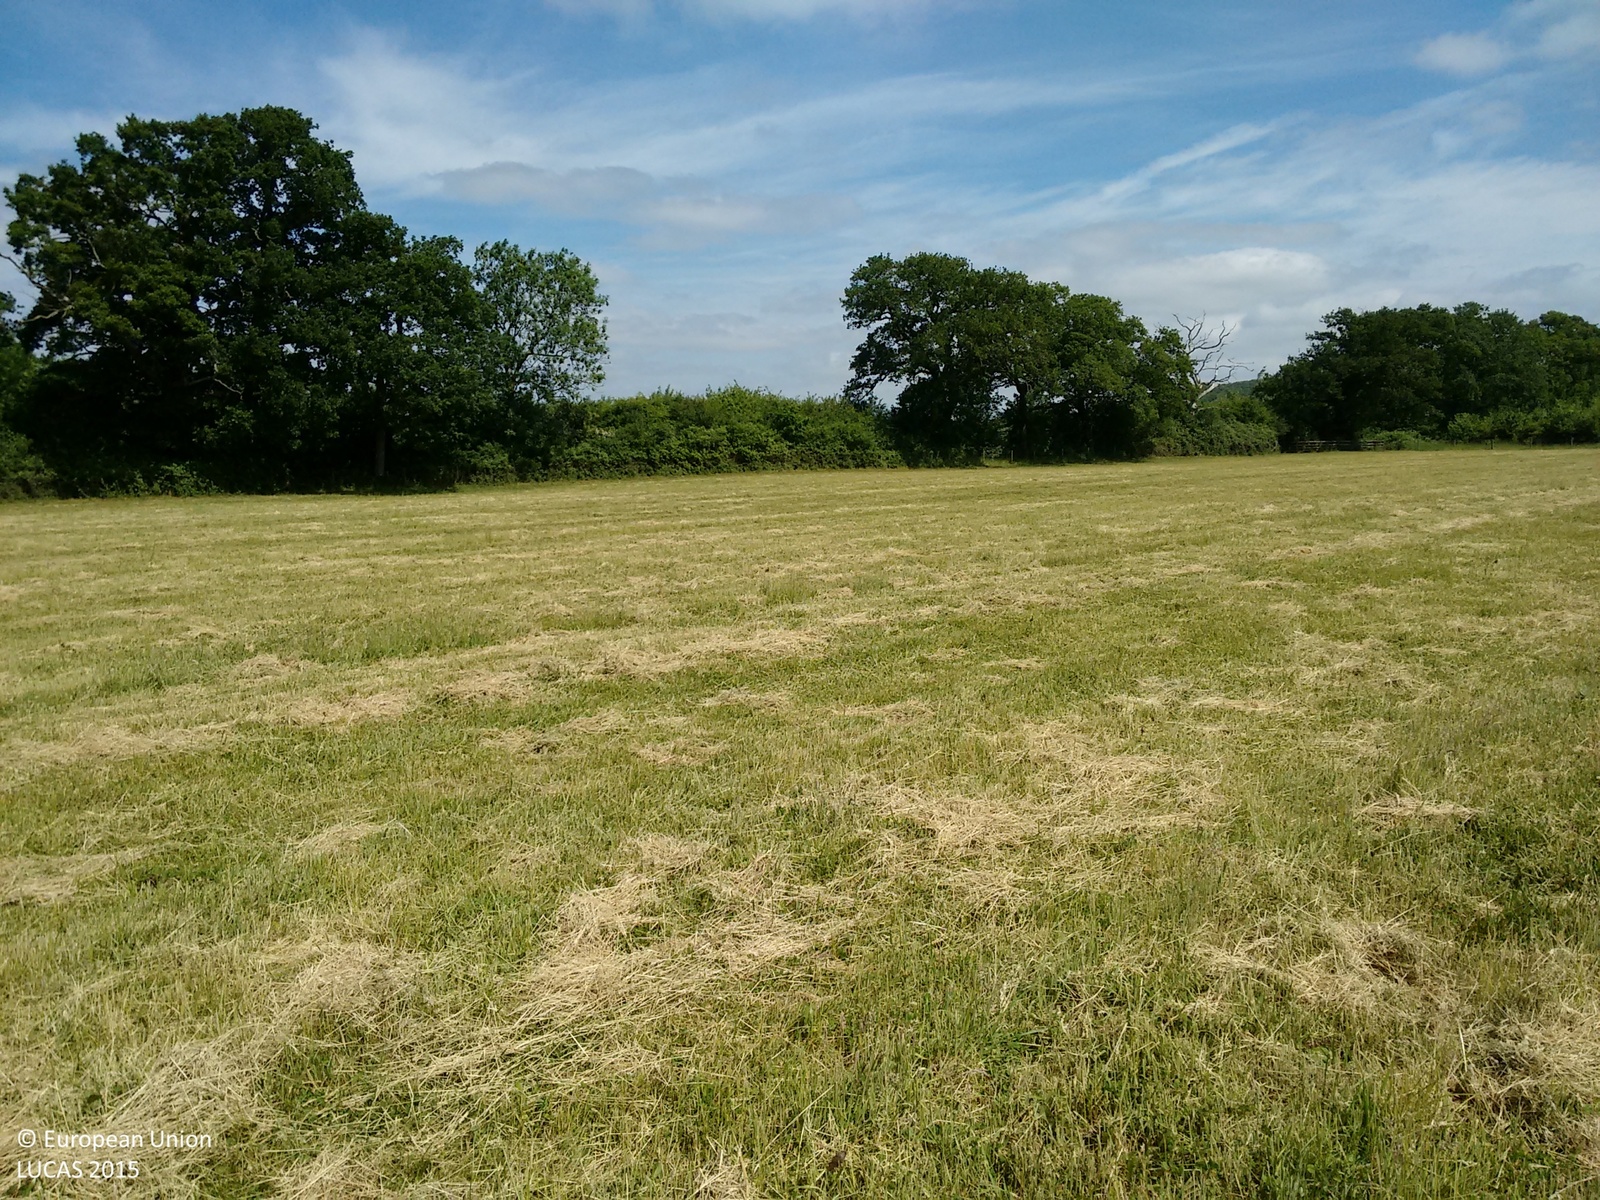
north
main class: Grassland
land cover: Grassland without tree/shrub cover
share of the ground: > 75 %
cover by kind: herbaceous plants 100 %
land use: Agriculture (excluding fallow land and kitchen gardens)
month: June
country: GB
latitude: 51.8679
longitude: -1.1566
